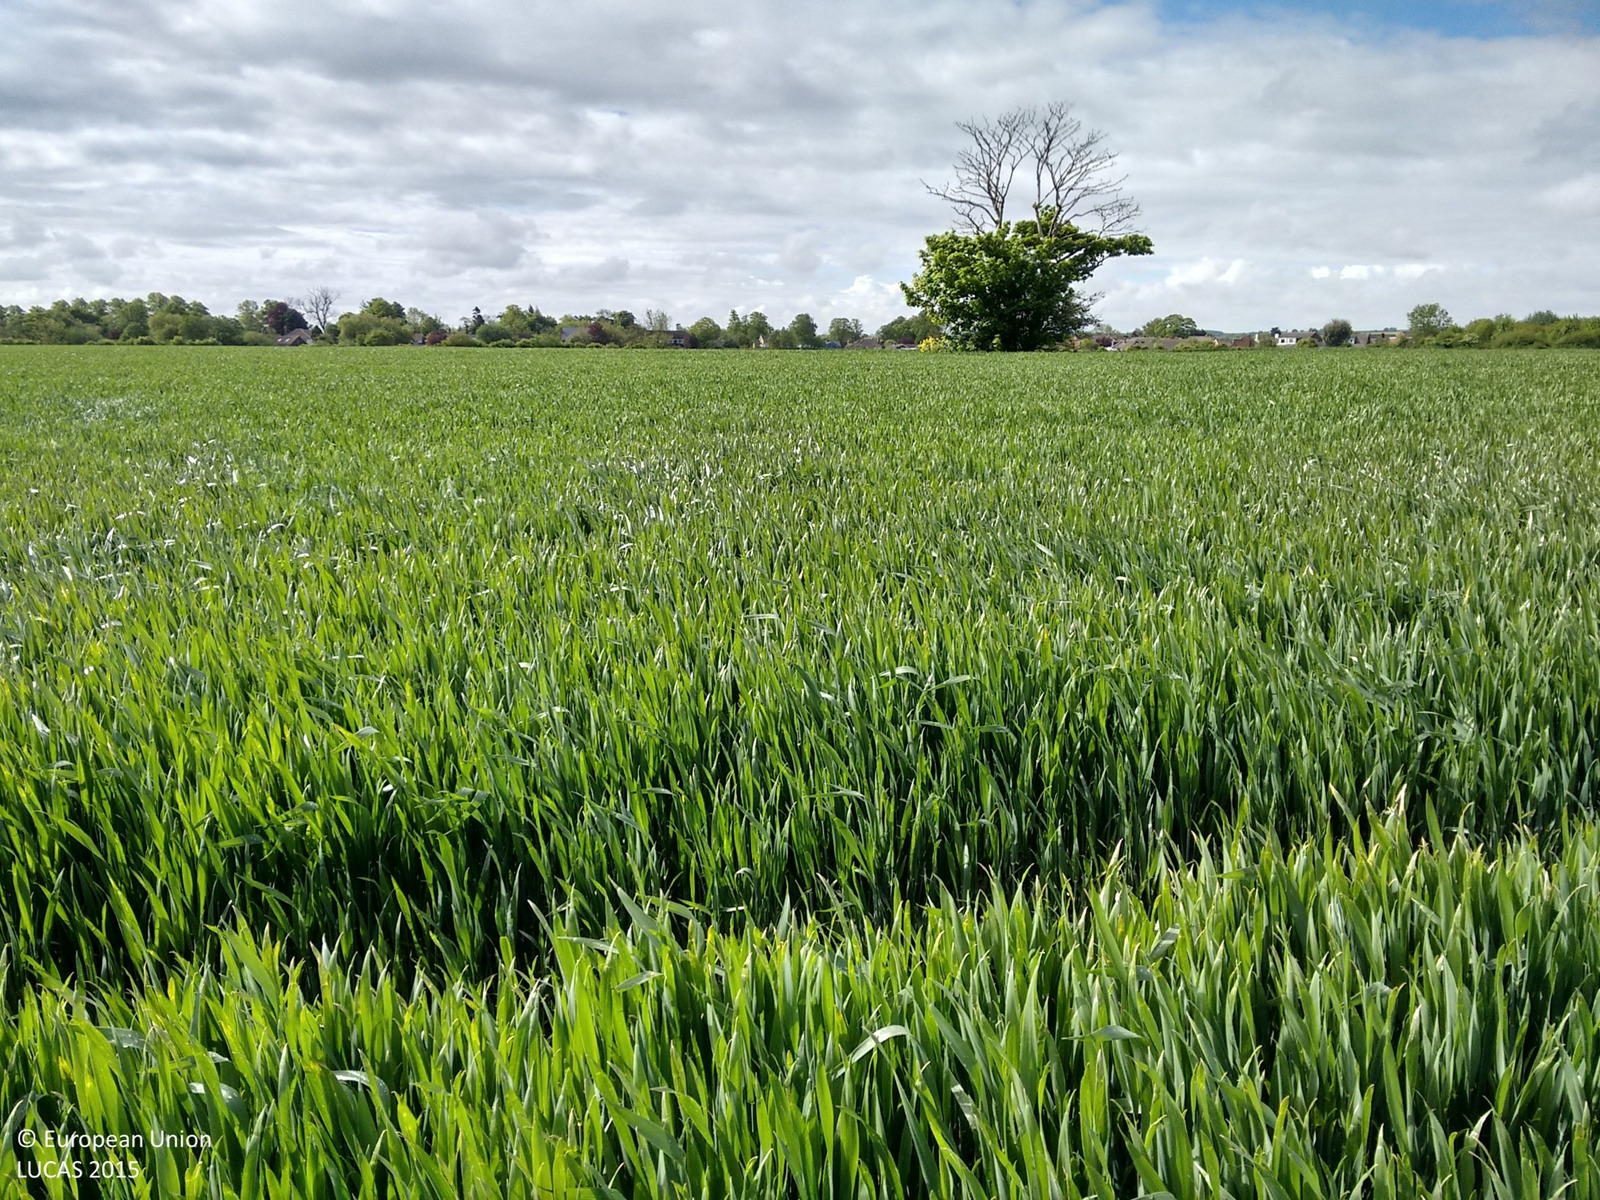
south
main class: Cropland
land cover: Common wheat
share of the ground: > 75 %
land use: Agriculture (excluding fallow land and kitchen gardens)
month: May
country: GB
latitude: 53.4721
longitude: -0.0508
